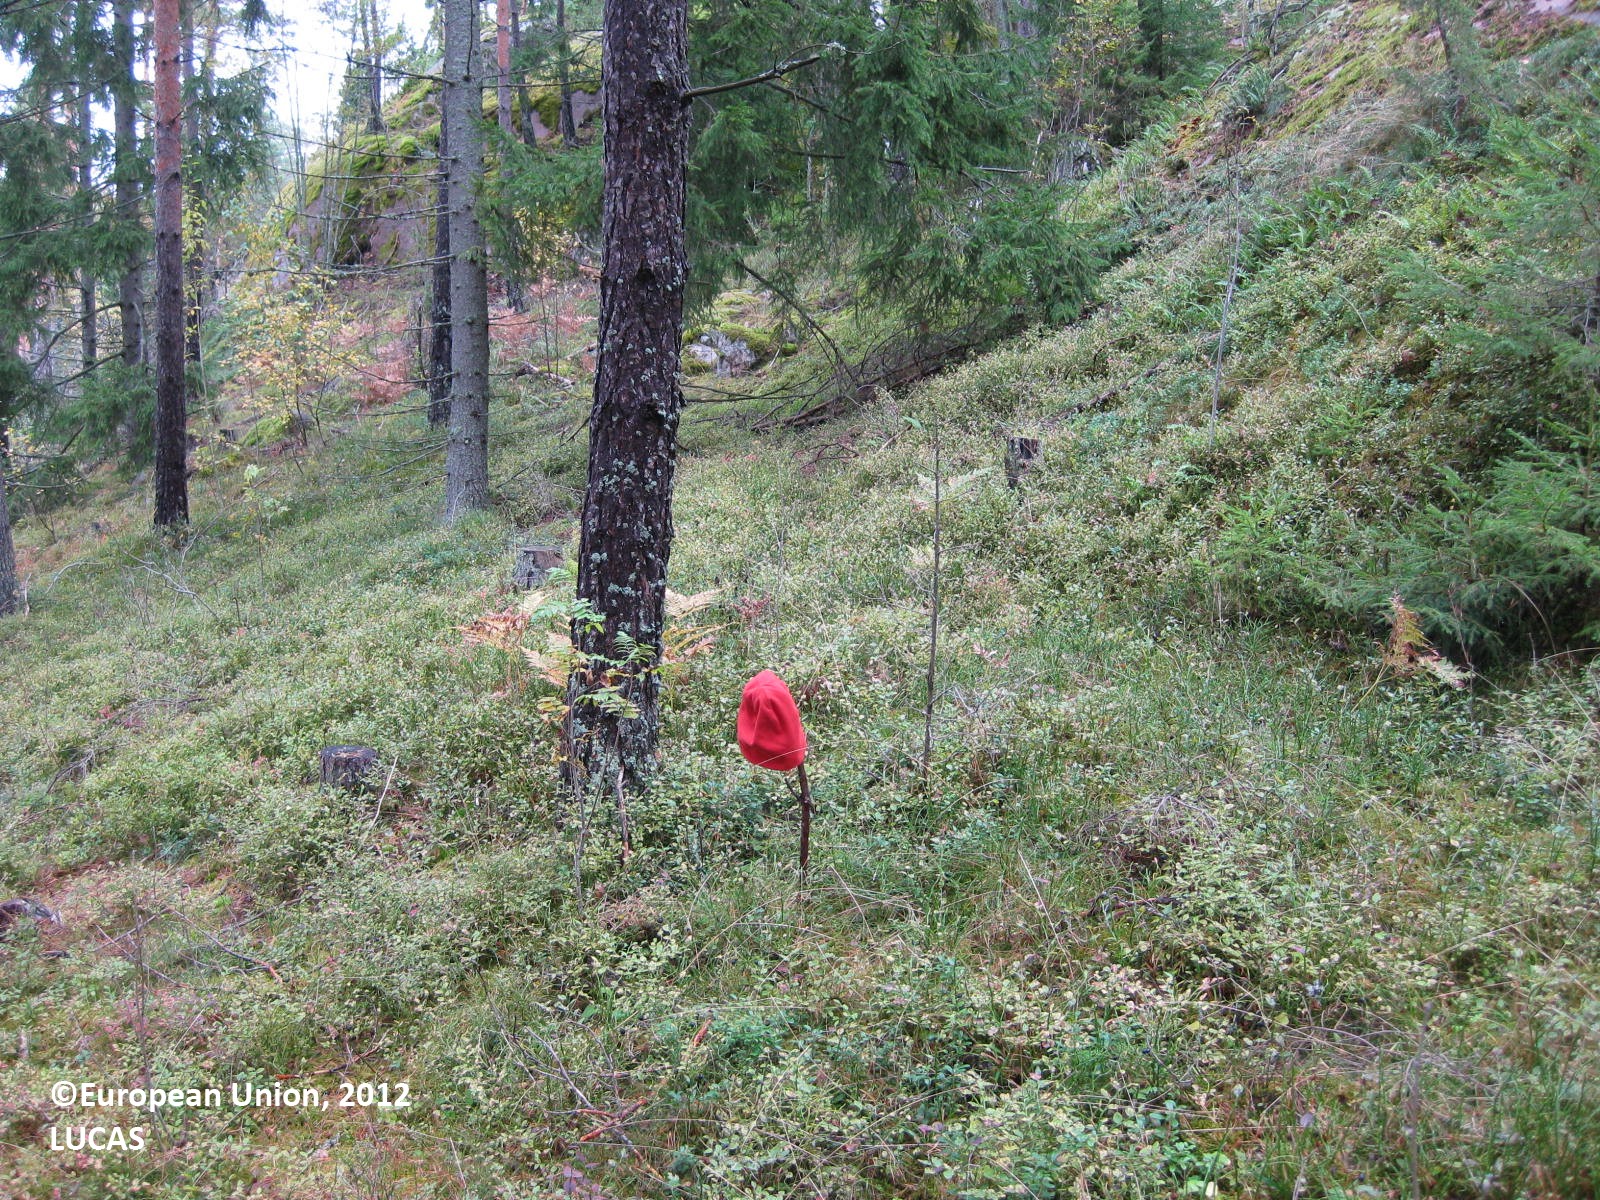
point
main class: Woodland
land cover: Other coniferous woodland
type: boreal forest
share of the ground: 25 - 50 %
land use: Forestry
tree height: > 5 m
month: September
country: FI
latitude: 60.3079
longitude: 22.1746
